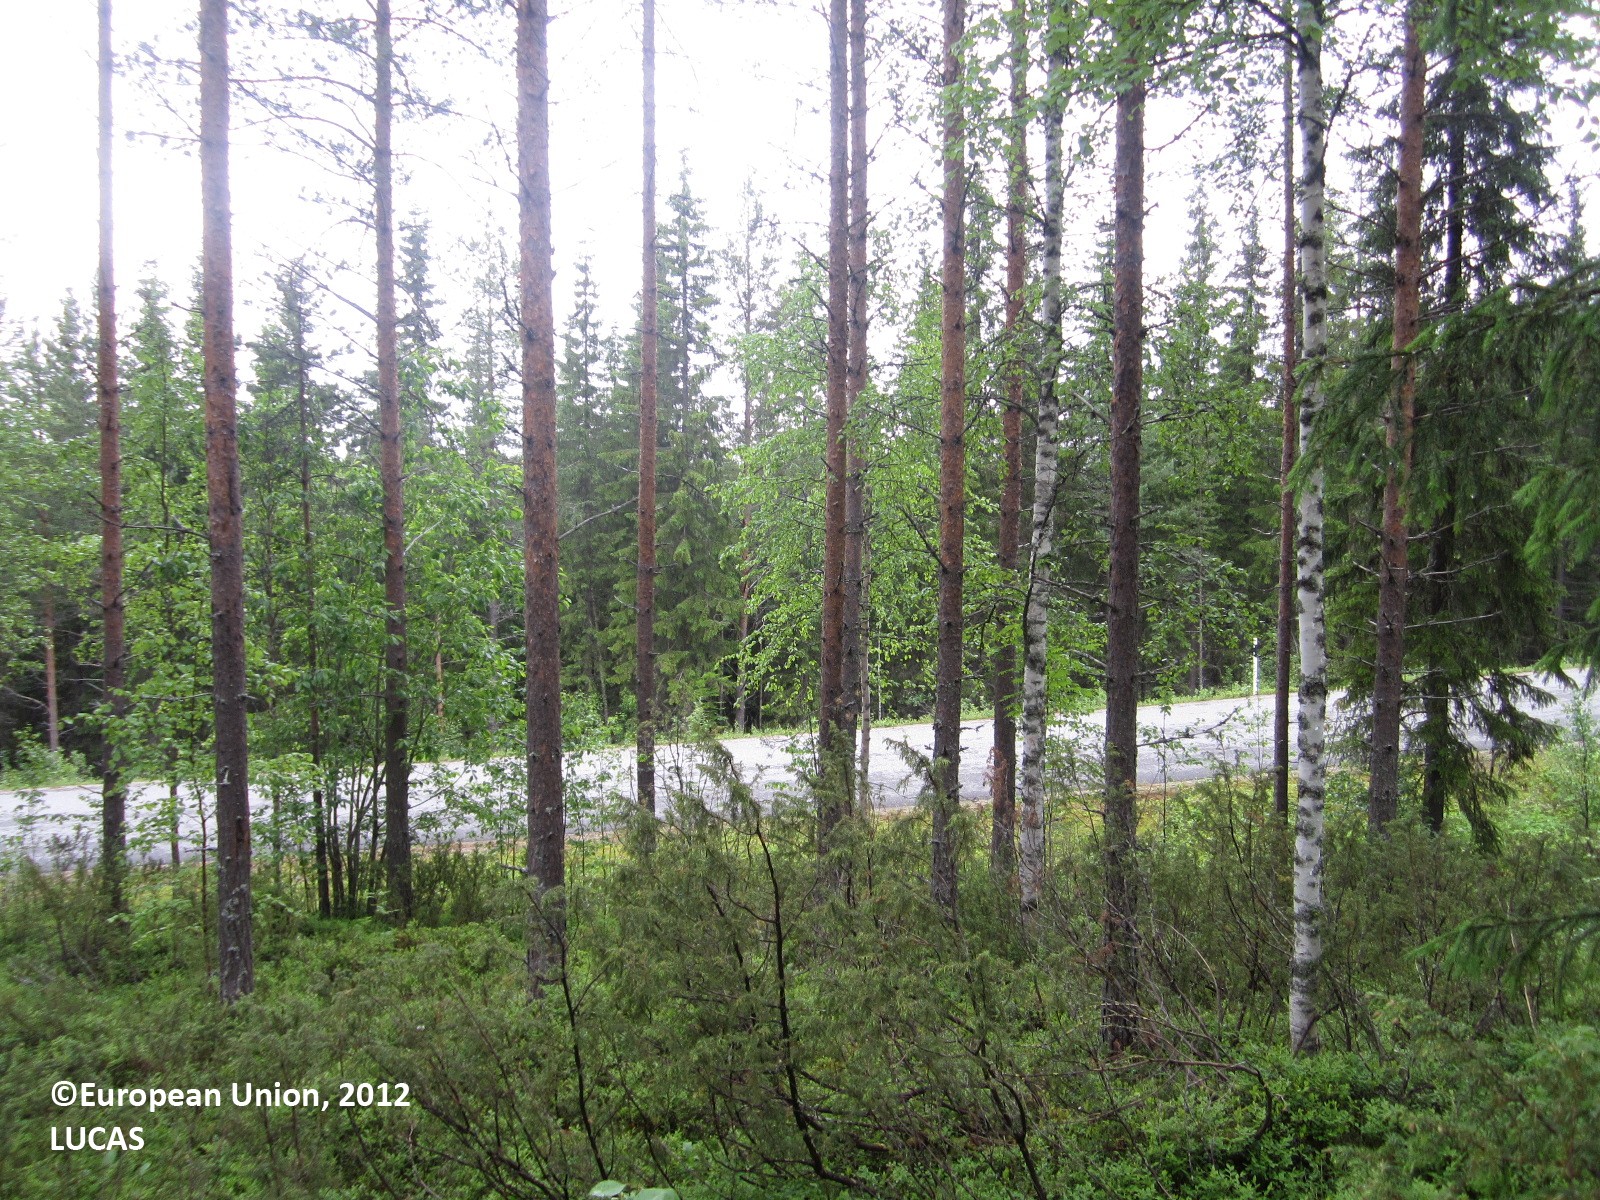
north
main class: Woodland
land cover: Other coniferous woodland
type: boreal forest
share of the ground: > 75 %
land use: Forestry
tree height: > 5 m
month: June
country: FI
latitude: 64.5542
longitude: 29.2044
